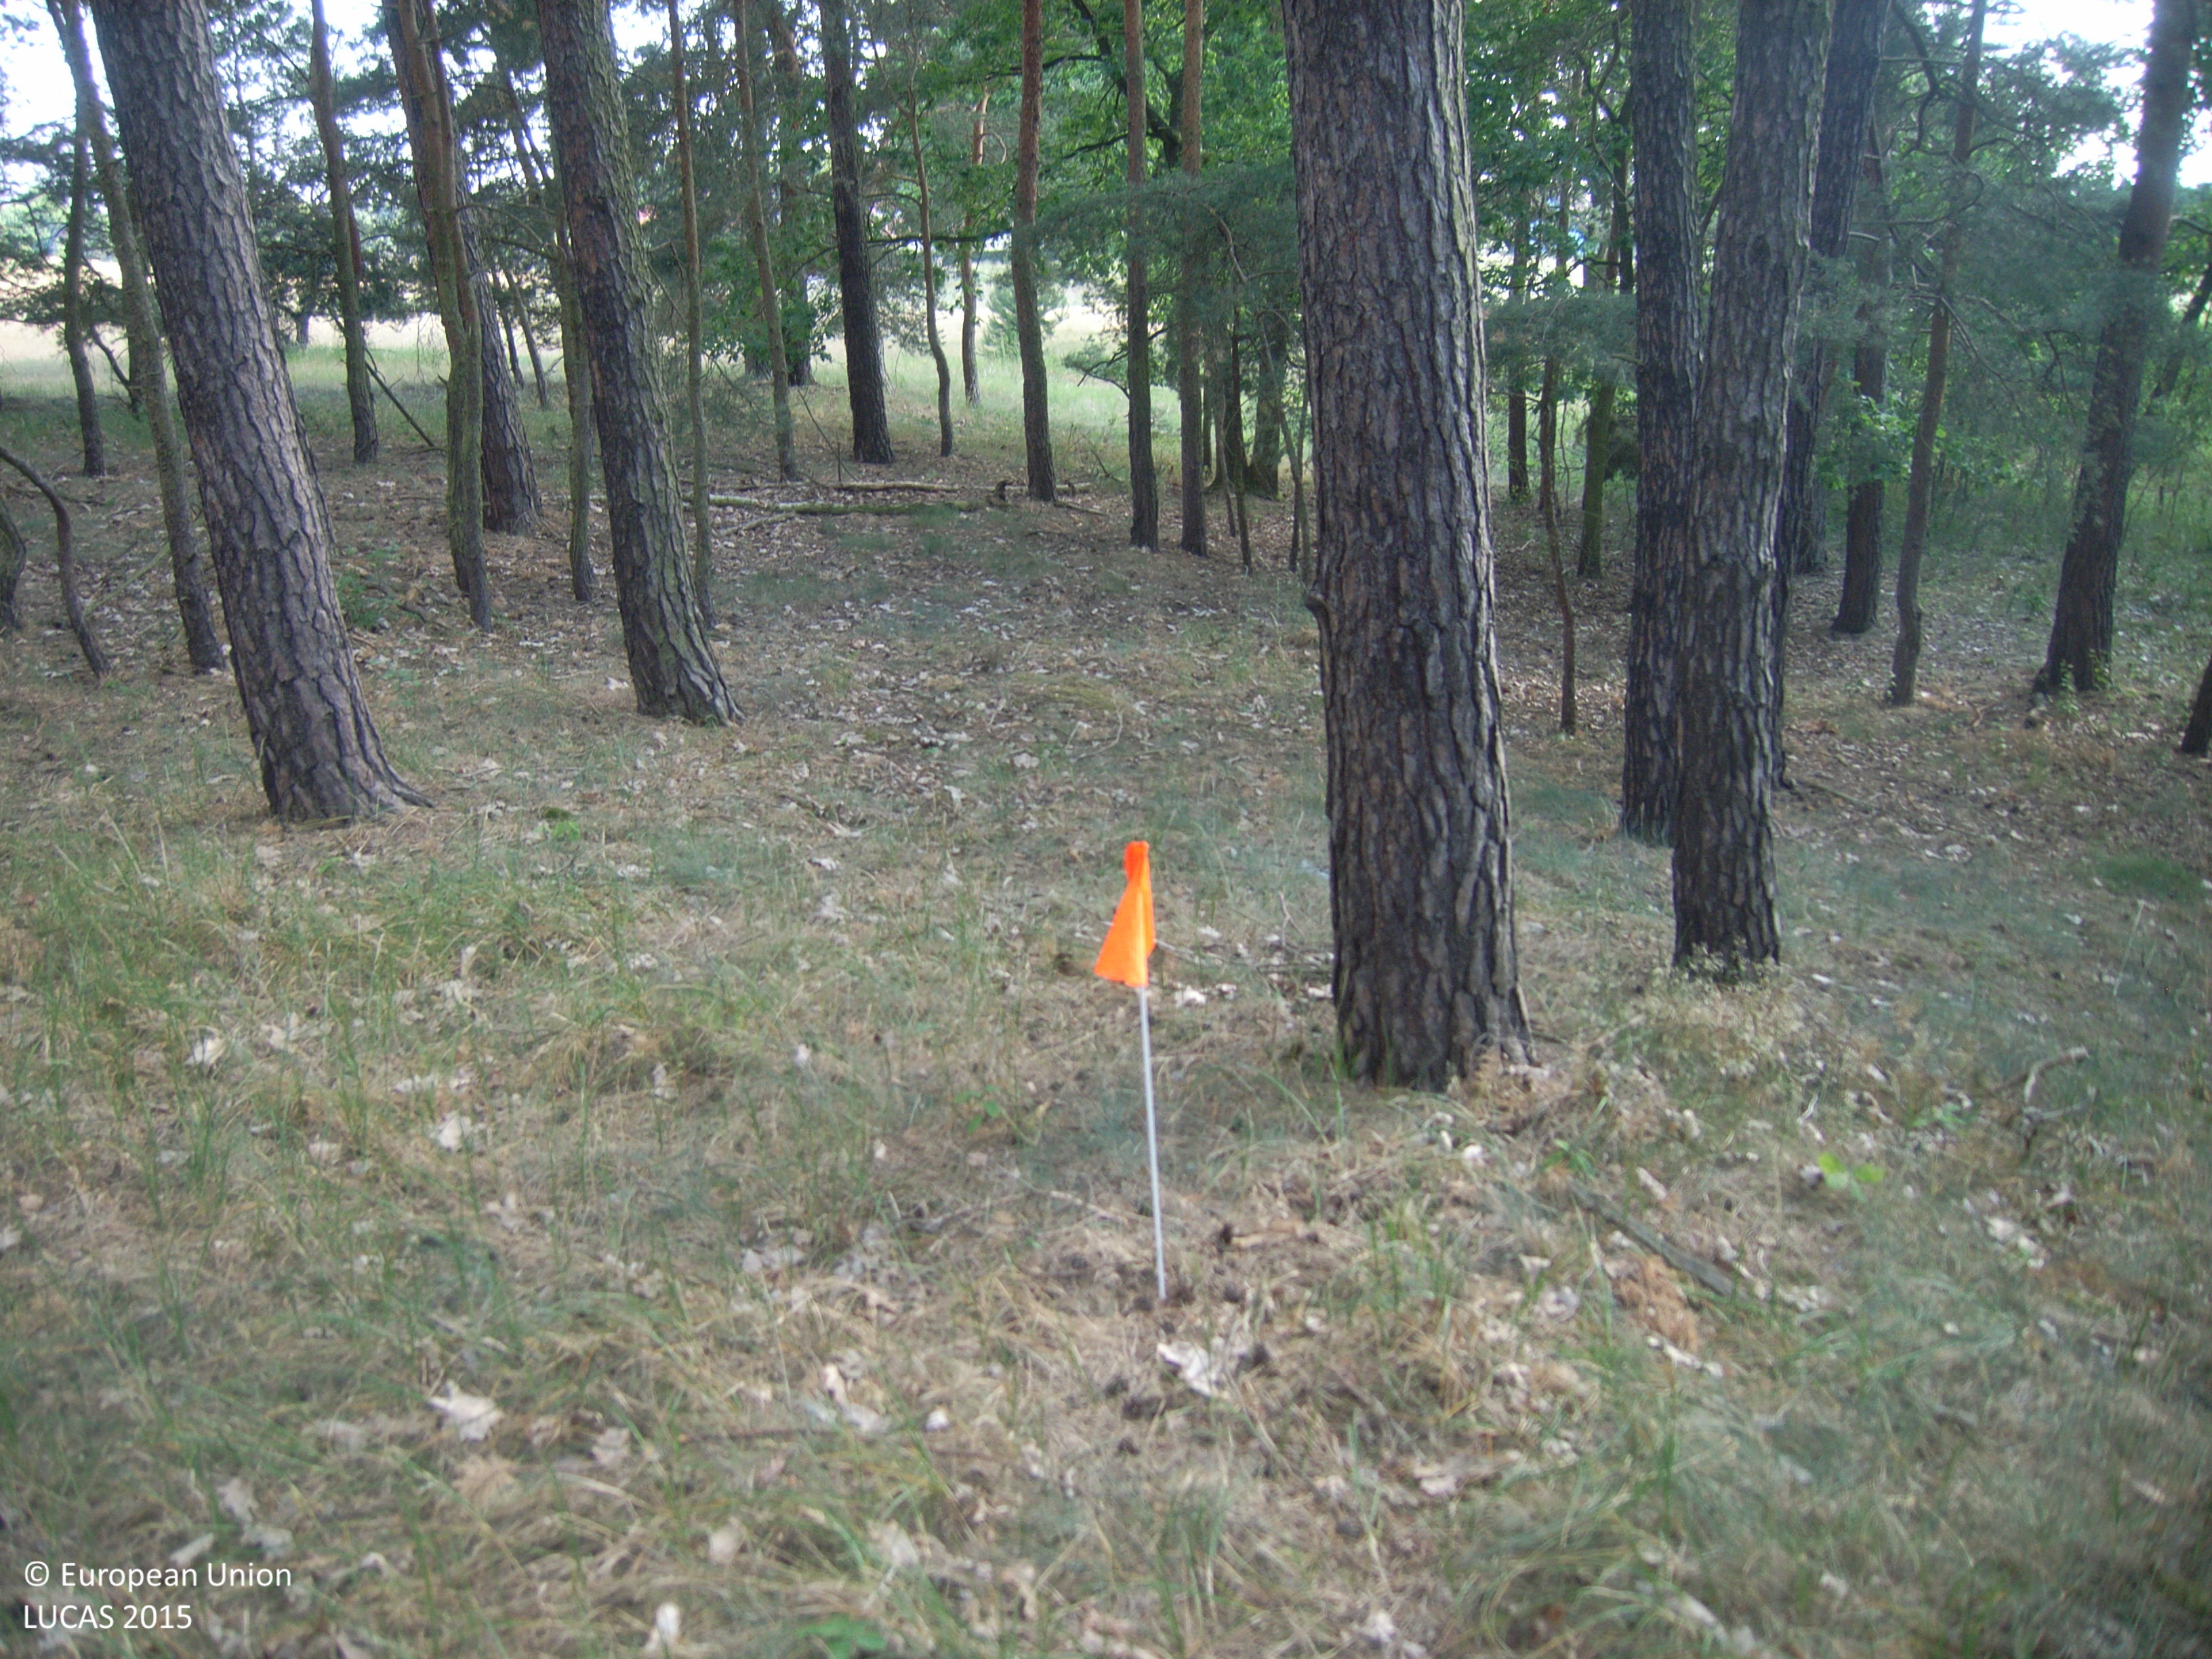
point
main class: Woodland
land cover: Pine dominated coniferous woodland
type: hemiboreal forest and nemoral coniferous forest and mixed broadleaved-coniferous forest
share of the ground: > 75 %
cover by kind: coniferous forest trees 95 %, herbaceous plants 5 %
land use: Forestry
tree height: > 5 m
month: June
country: DE
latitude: 52.0727
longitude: 14.1007
